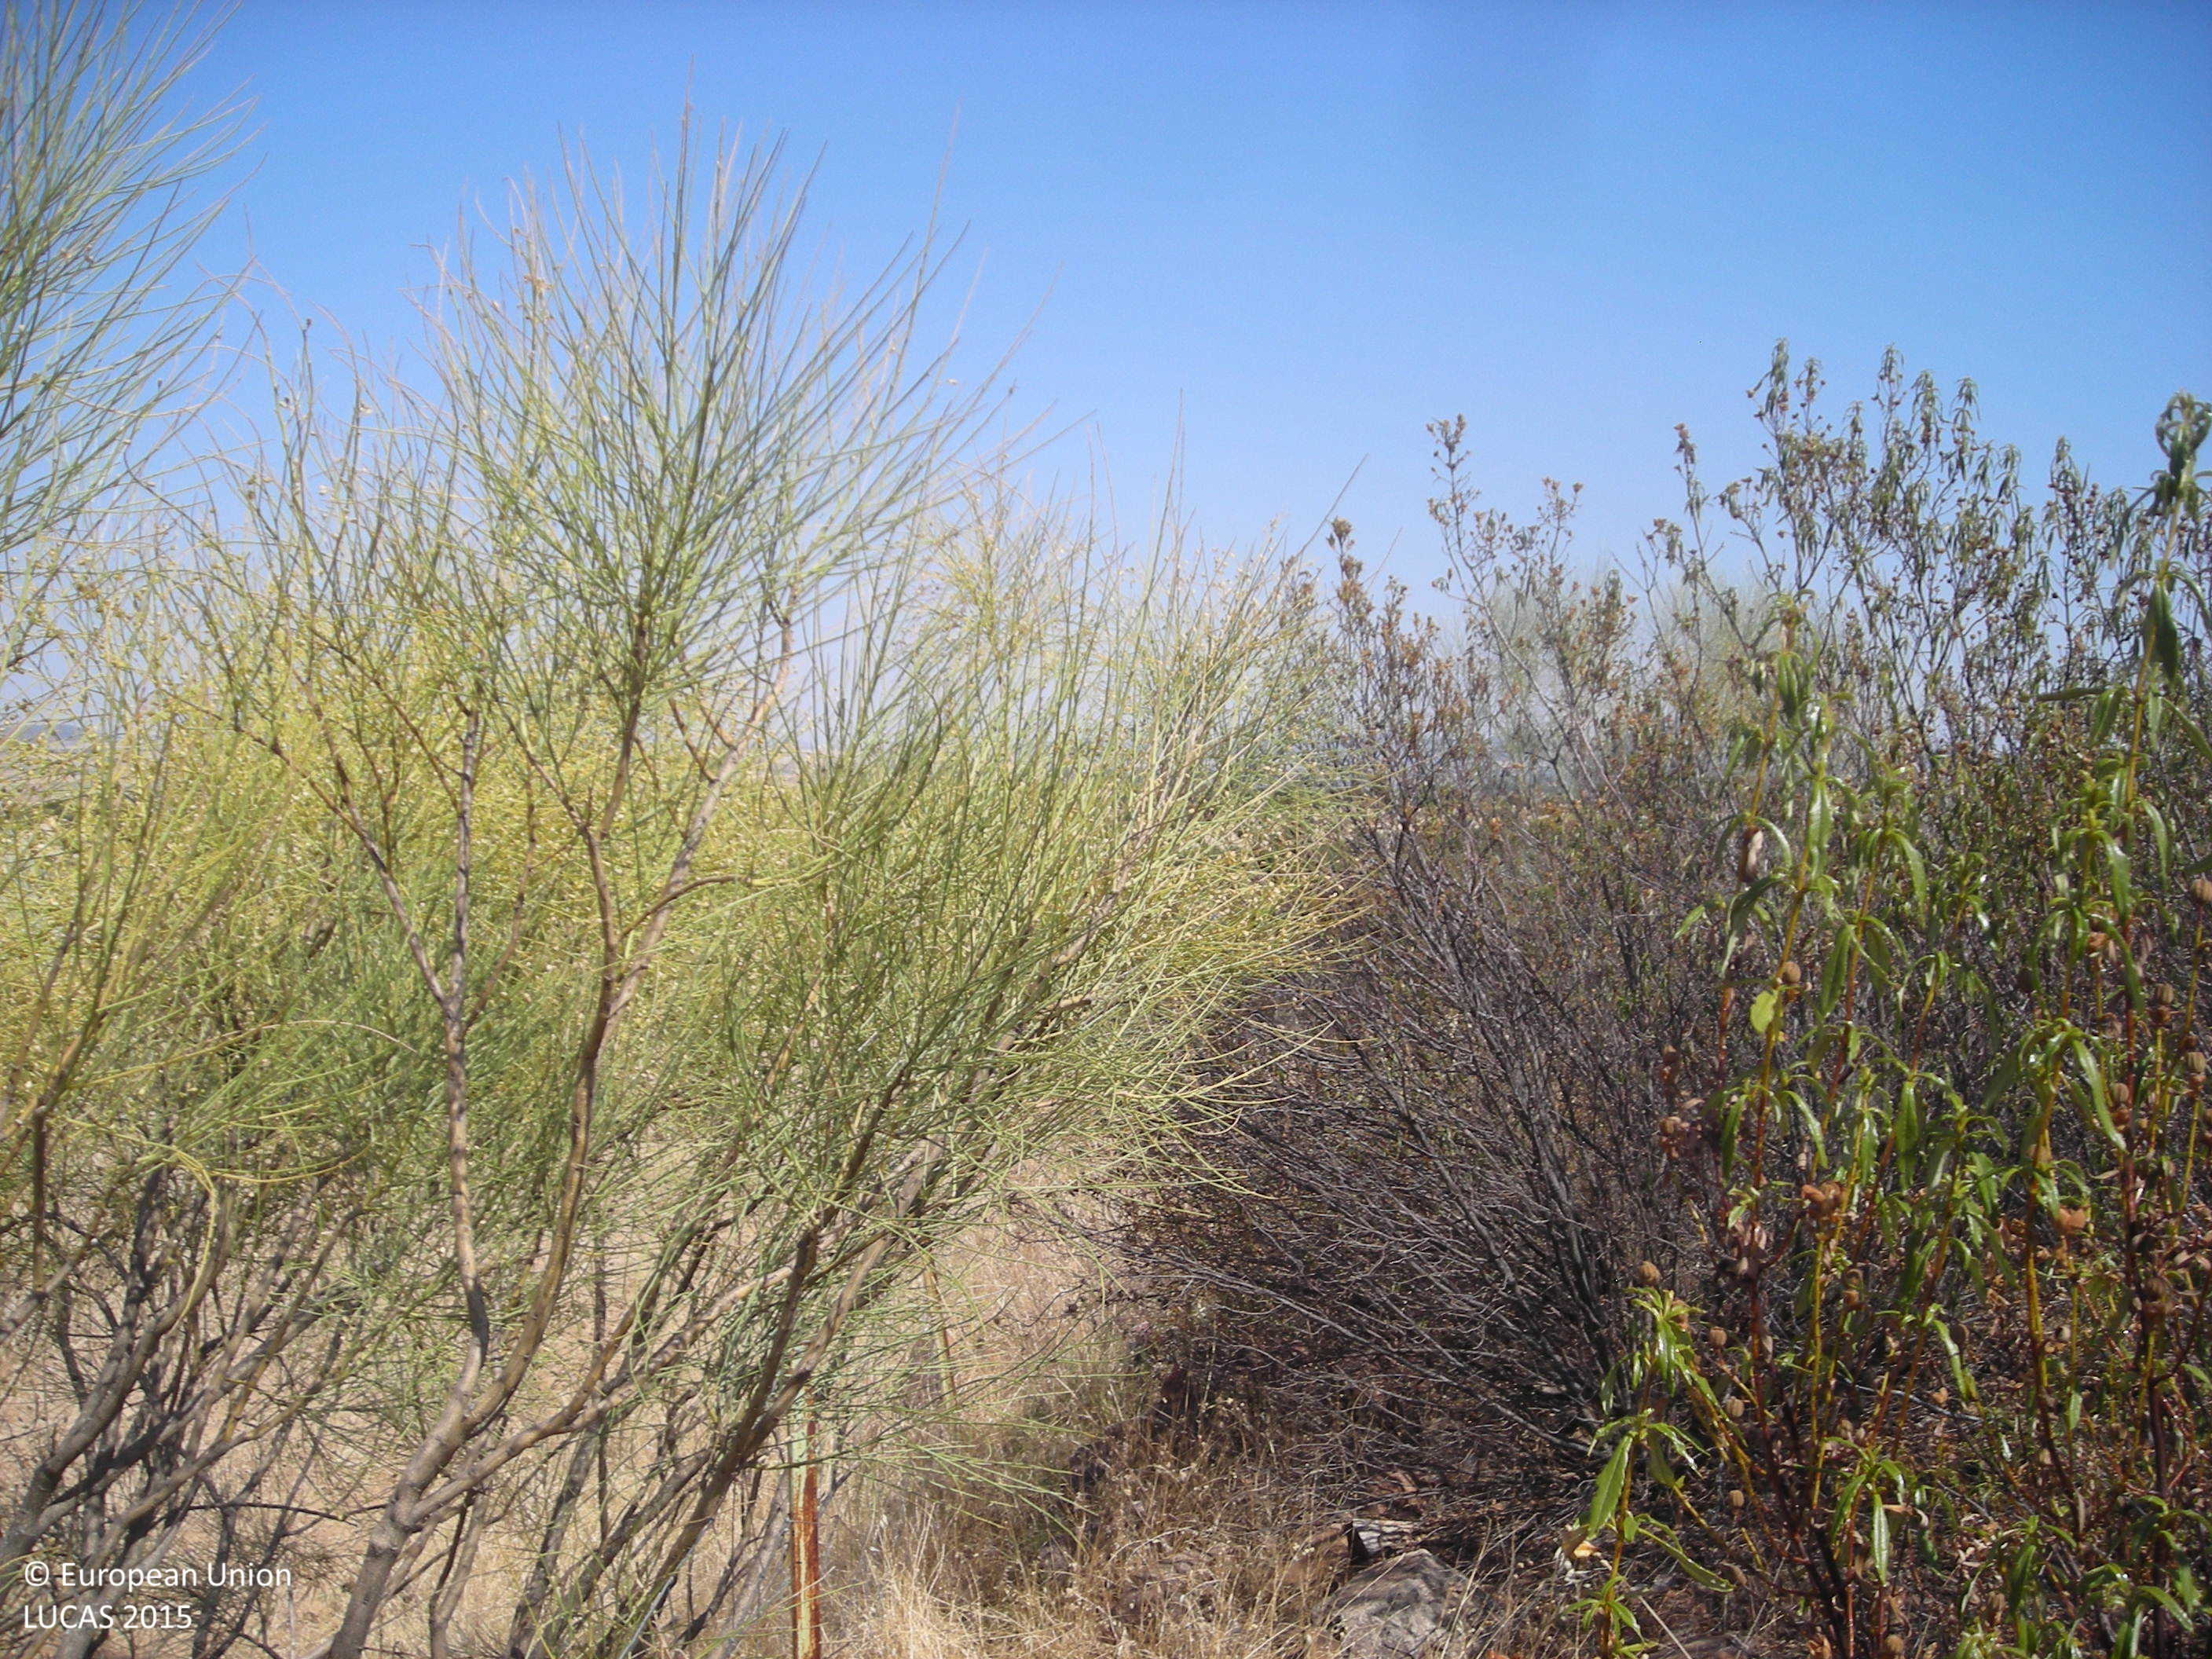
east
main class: Shrubland
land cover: Shrubland without tree cover
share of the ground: > 75 %
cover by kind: shrubs 100 %
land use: Semi-natural and natural areas not in use
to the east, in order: Shrubland without tree cover; Broadleaved woodland; Fences; Other bare soil; Grassland with sparse tree/shrub cover
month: July
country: ES
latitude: 38.6930
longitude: -5.8533
